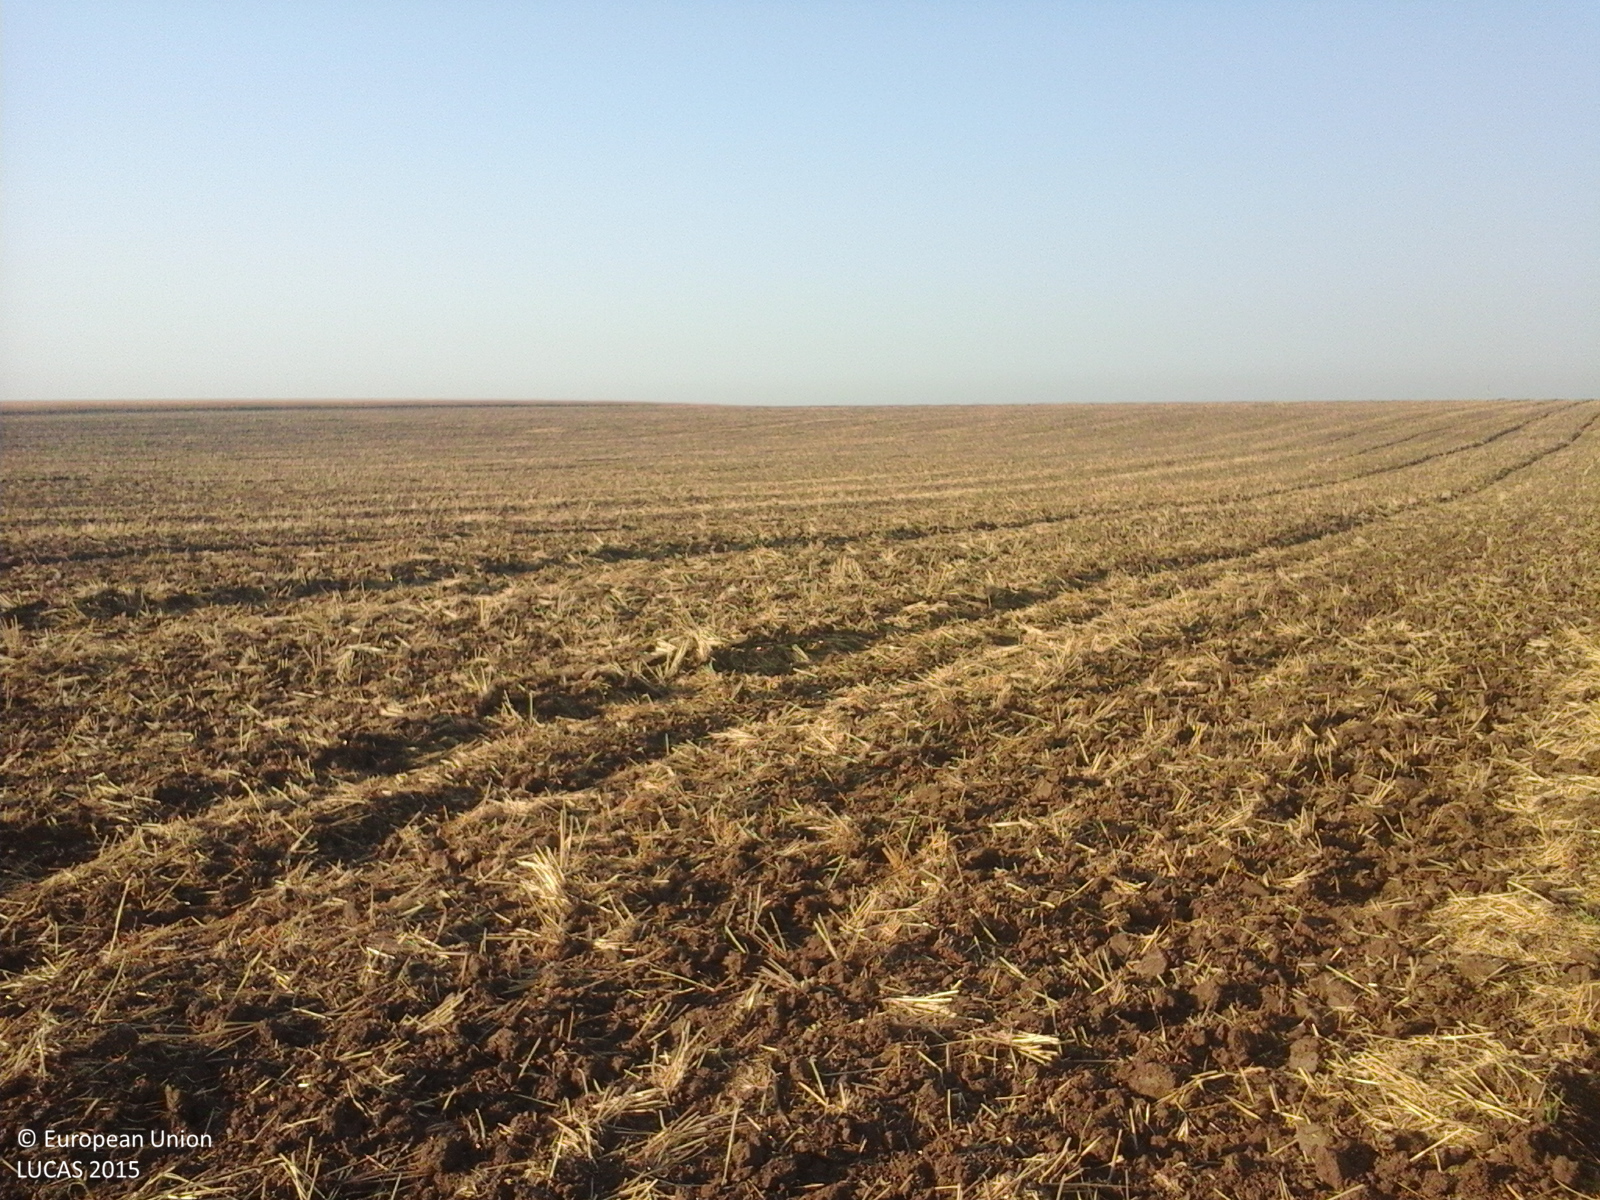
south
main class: Cropland
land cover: Common wheat
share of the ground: < 10 %
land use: Agriculture (excluding fallow land and kitchen gardens)
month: August
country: RO
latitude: 44.1922
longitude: 23.0937
